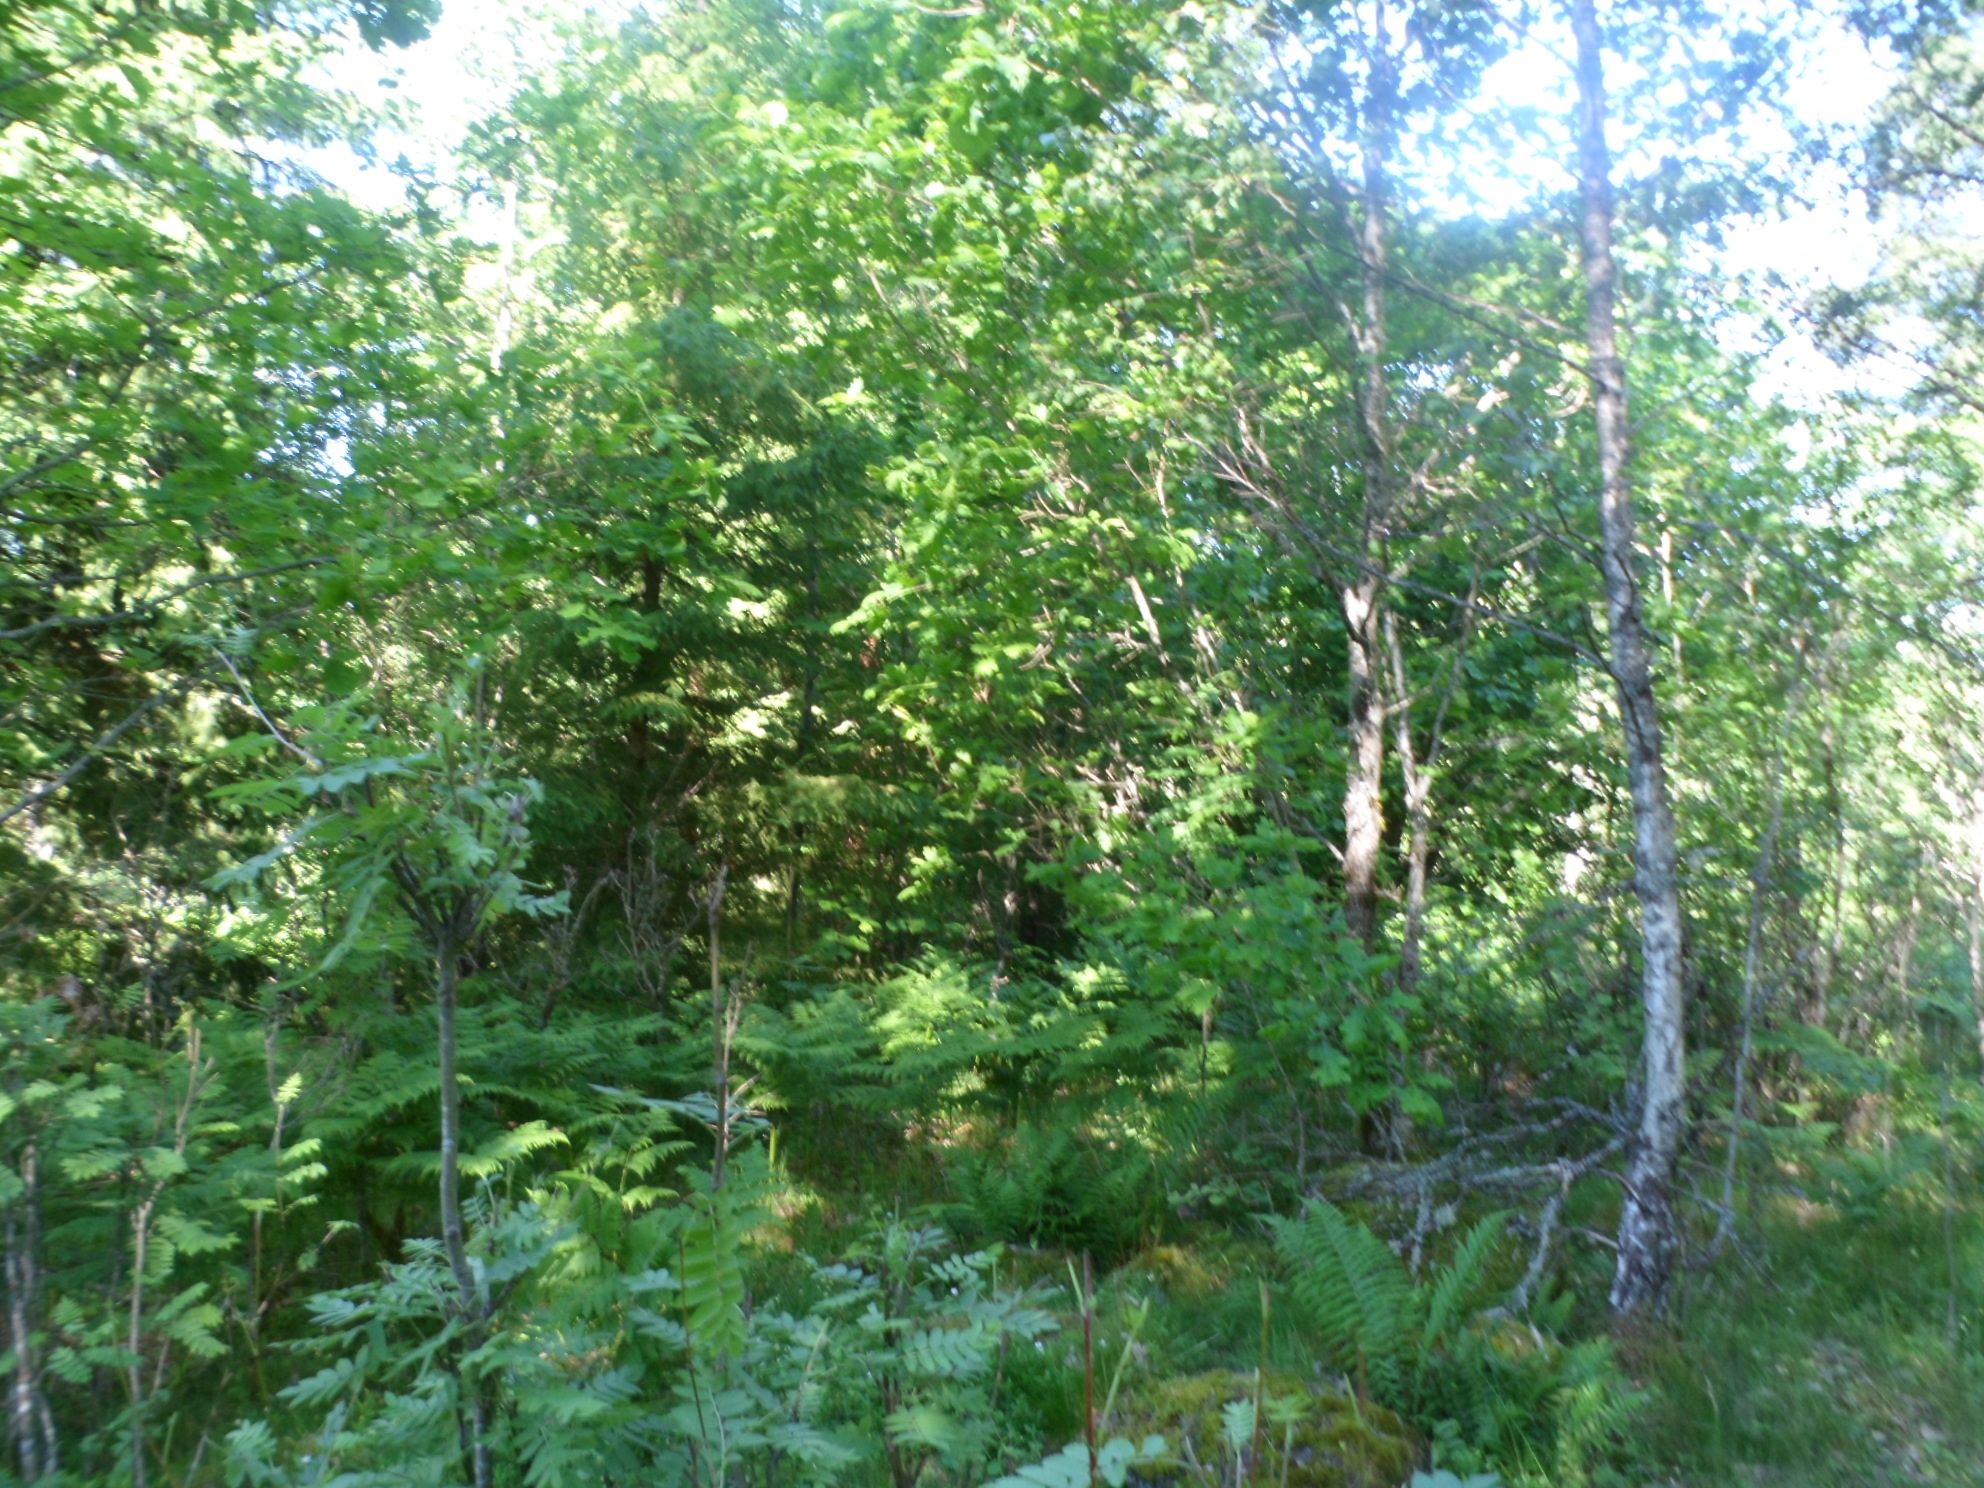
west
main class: Woodland
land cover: Pine dominated mixed woodland
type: boreal forest
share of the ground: 50 - 75 %
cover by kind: coniferous forest trees 30 %, broadleaved forest trees 30 %, herbaceous plants 20 %, shrubs 10 %, lichens and mosses 10 %
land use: Forestry
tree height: > 5 m
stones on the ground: 25 - 50 %
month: July
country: SE
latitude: 57.3157
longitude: 14.4956
